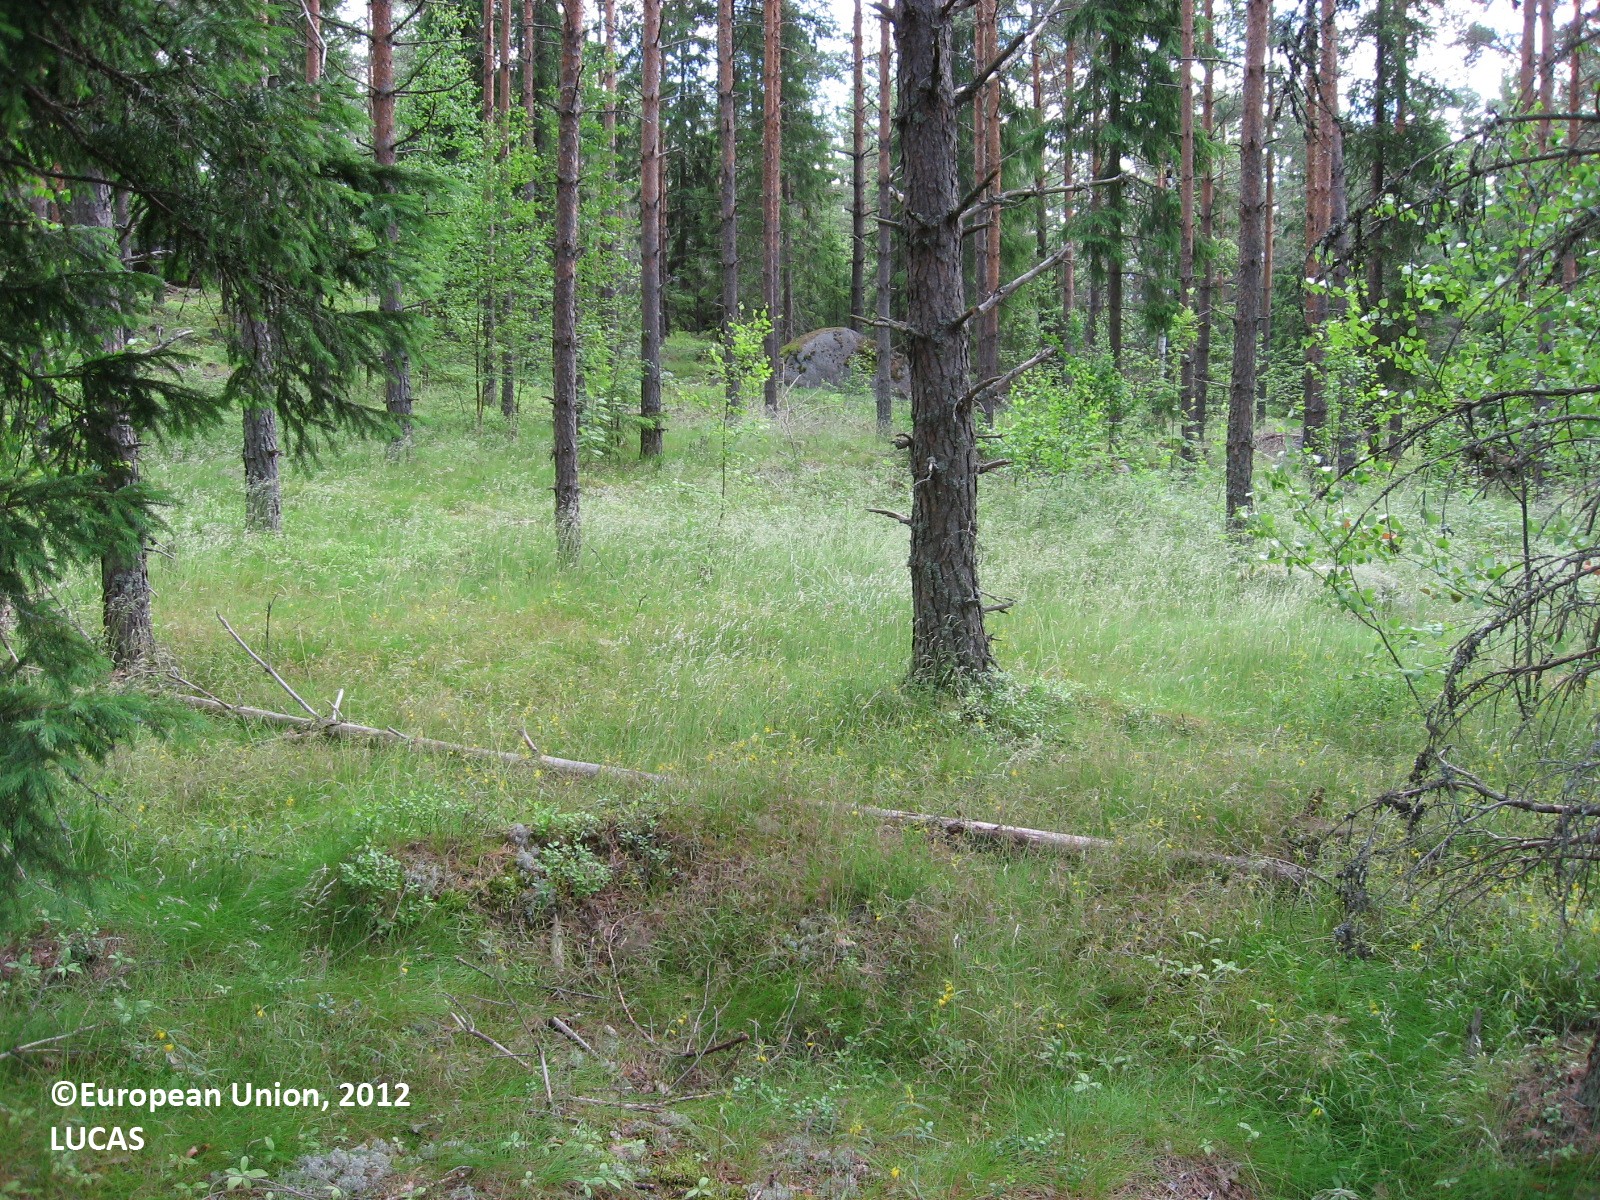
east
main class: Woodland
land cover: Pine dominated coniferous woodland
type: boreal forest
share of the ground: 25 - 50 %
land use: Forestry
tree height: > 5 m
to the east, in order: Pine dominated coniferous woodland; Pine dominated mixed woodland; Tracks; Grass margins; Other mixed woodland; Ditches and canals; Other mixed woodland; Ditches and canals; Broadleaved woodland; Ditches and canals; Broadleaved woodland
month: June
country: FI
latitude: 60.6926
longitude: 26.5093
